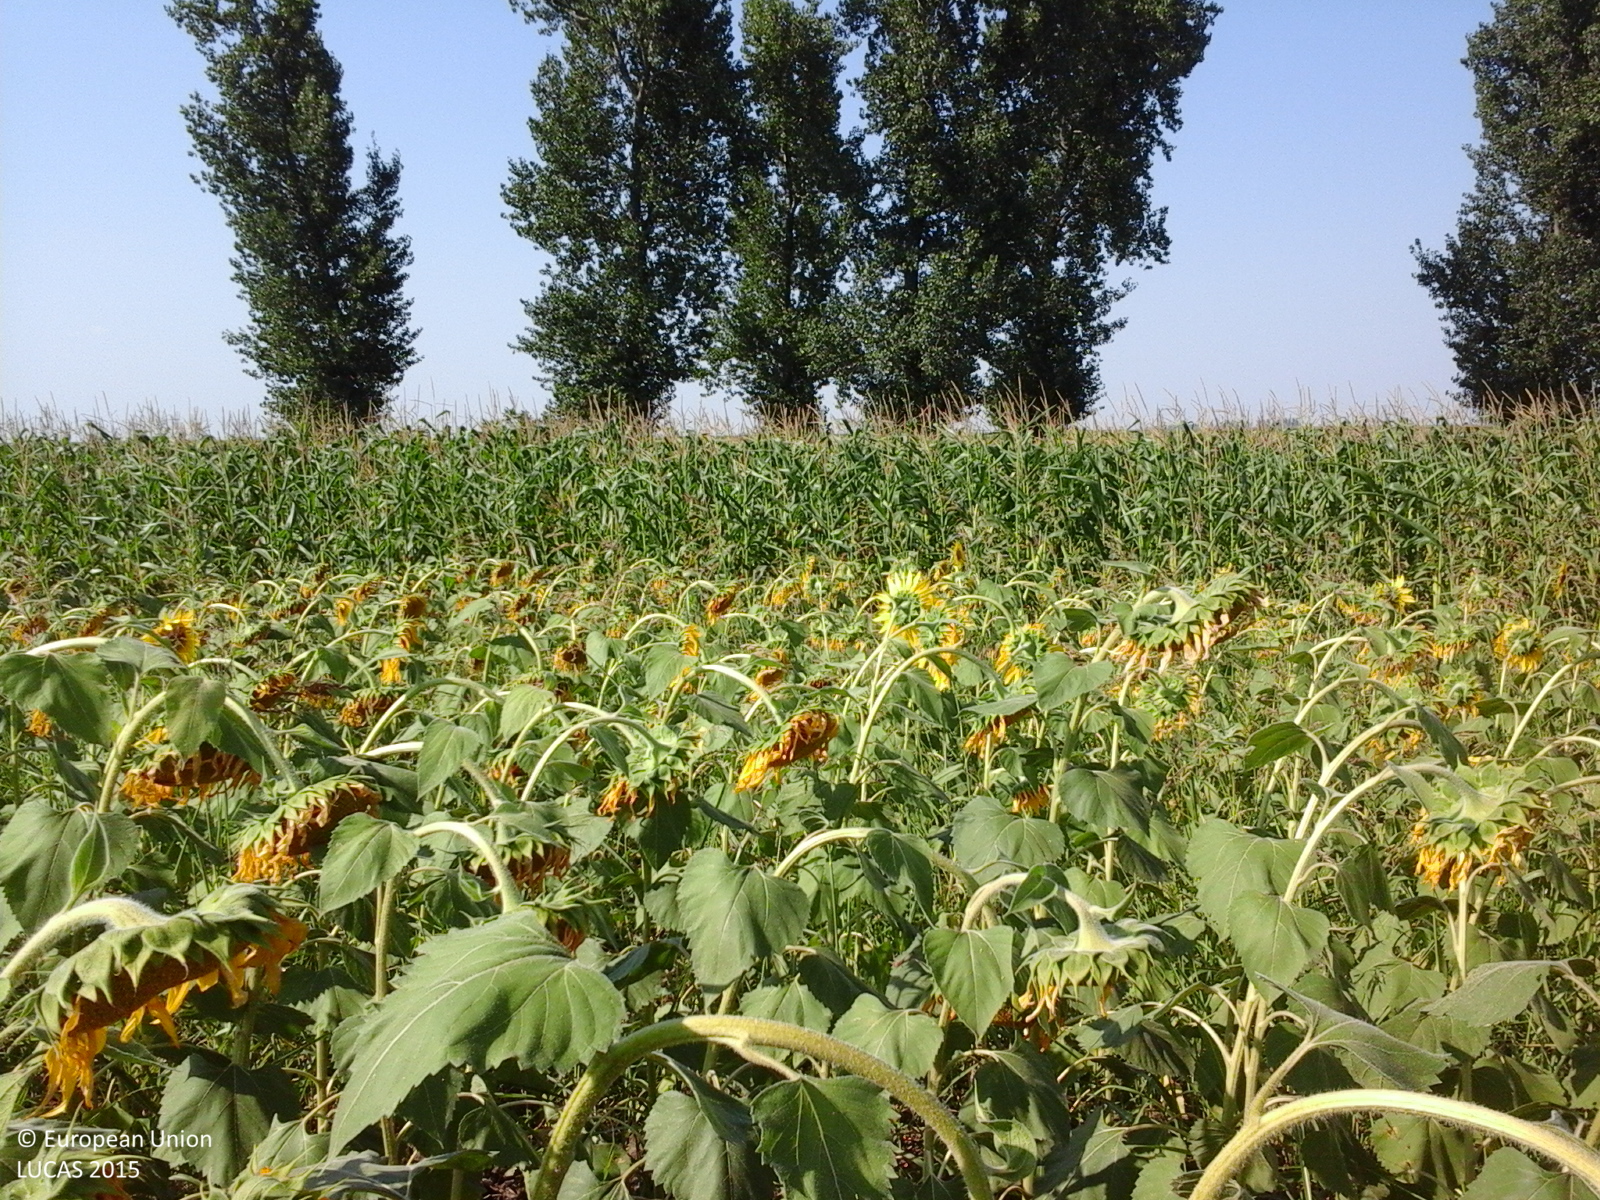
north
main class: Cropland
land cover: Sunflower
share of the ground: > 75 %
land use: Agriculture (excluding fallow land and kitchen gardens)
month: July
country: RO
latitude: 44.8645
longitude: 27.2377
